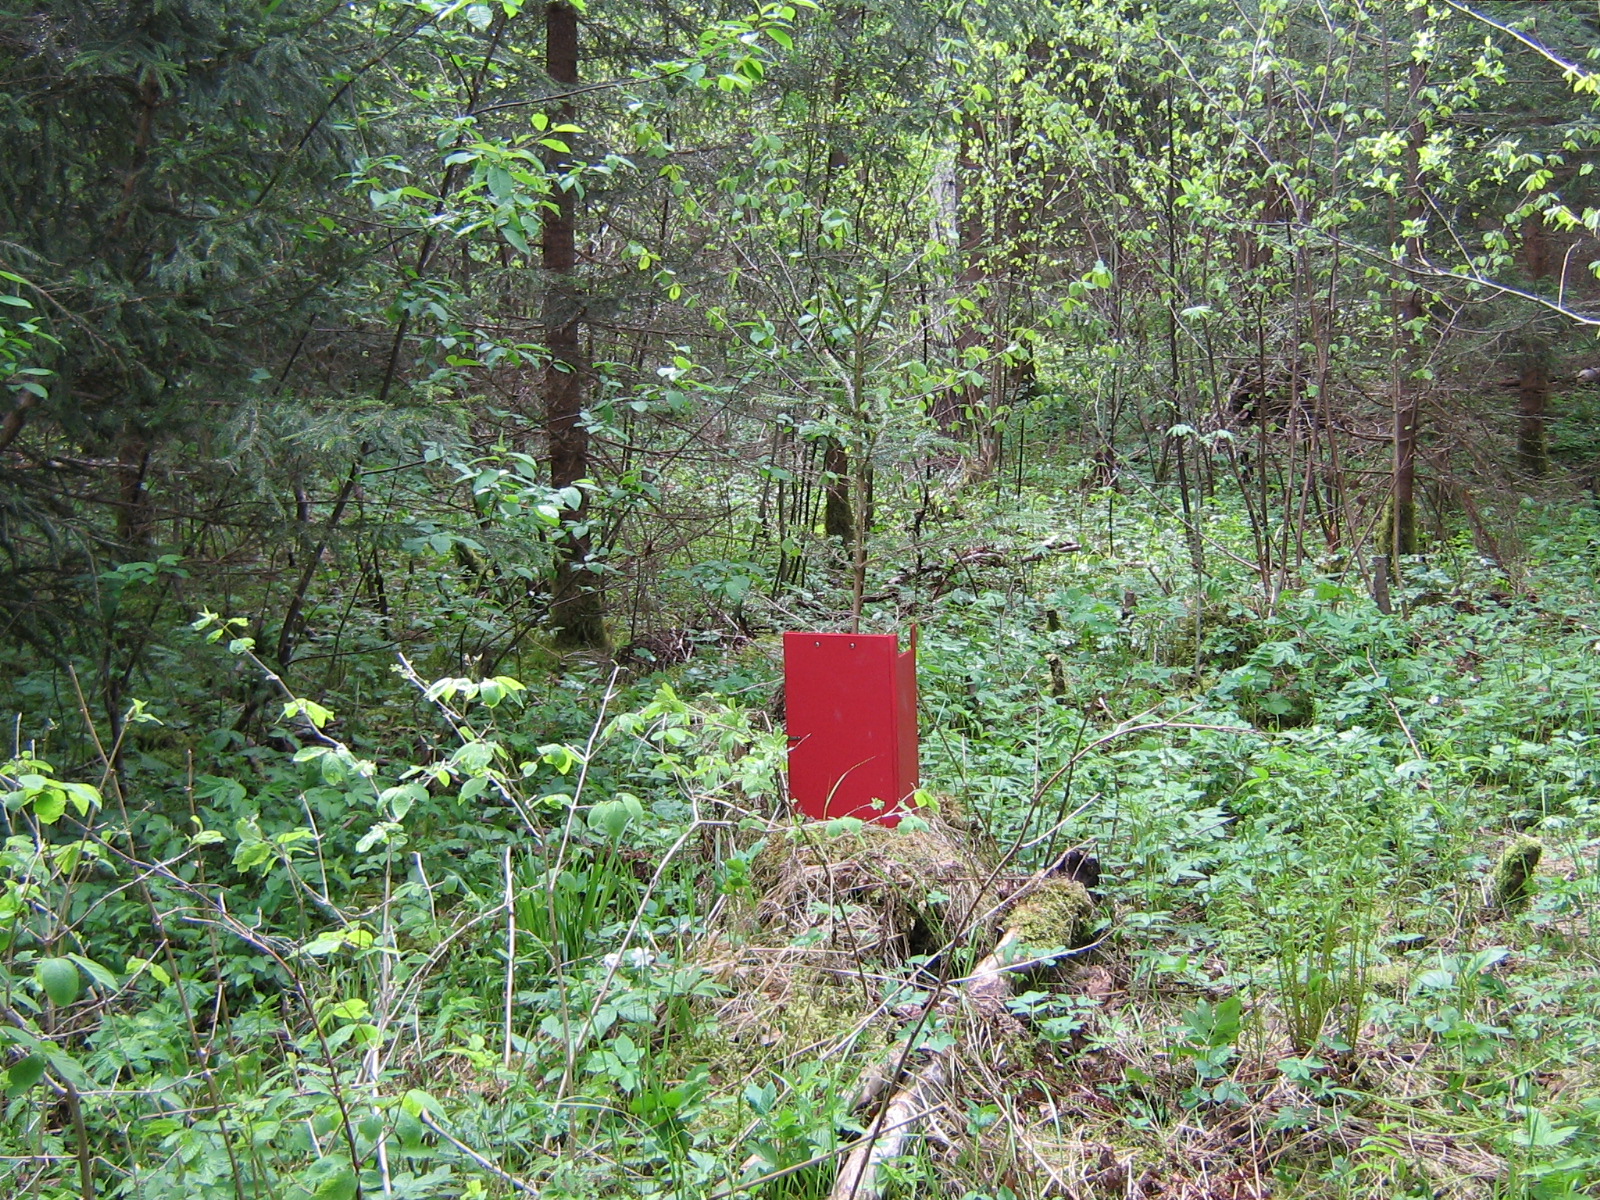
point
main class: Woodland
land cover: Spruce dominated mixed woodland
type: hemiboreal forest and nemoral coniferous forest and mixed broadleaved-coniferous forest
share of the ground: > 75 %
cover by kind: coniferous forest trees 75 %, broadleaved forest trees 25 %
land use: Forestry
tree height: > 5 m
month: May
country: LV
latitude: 57.2161
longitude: 25.5337
